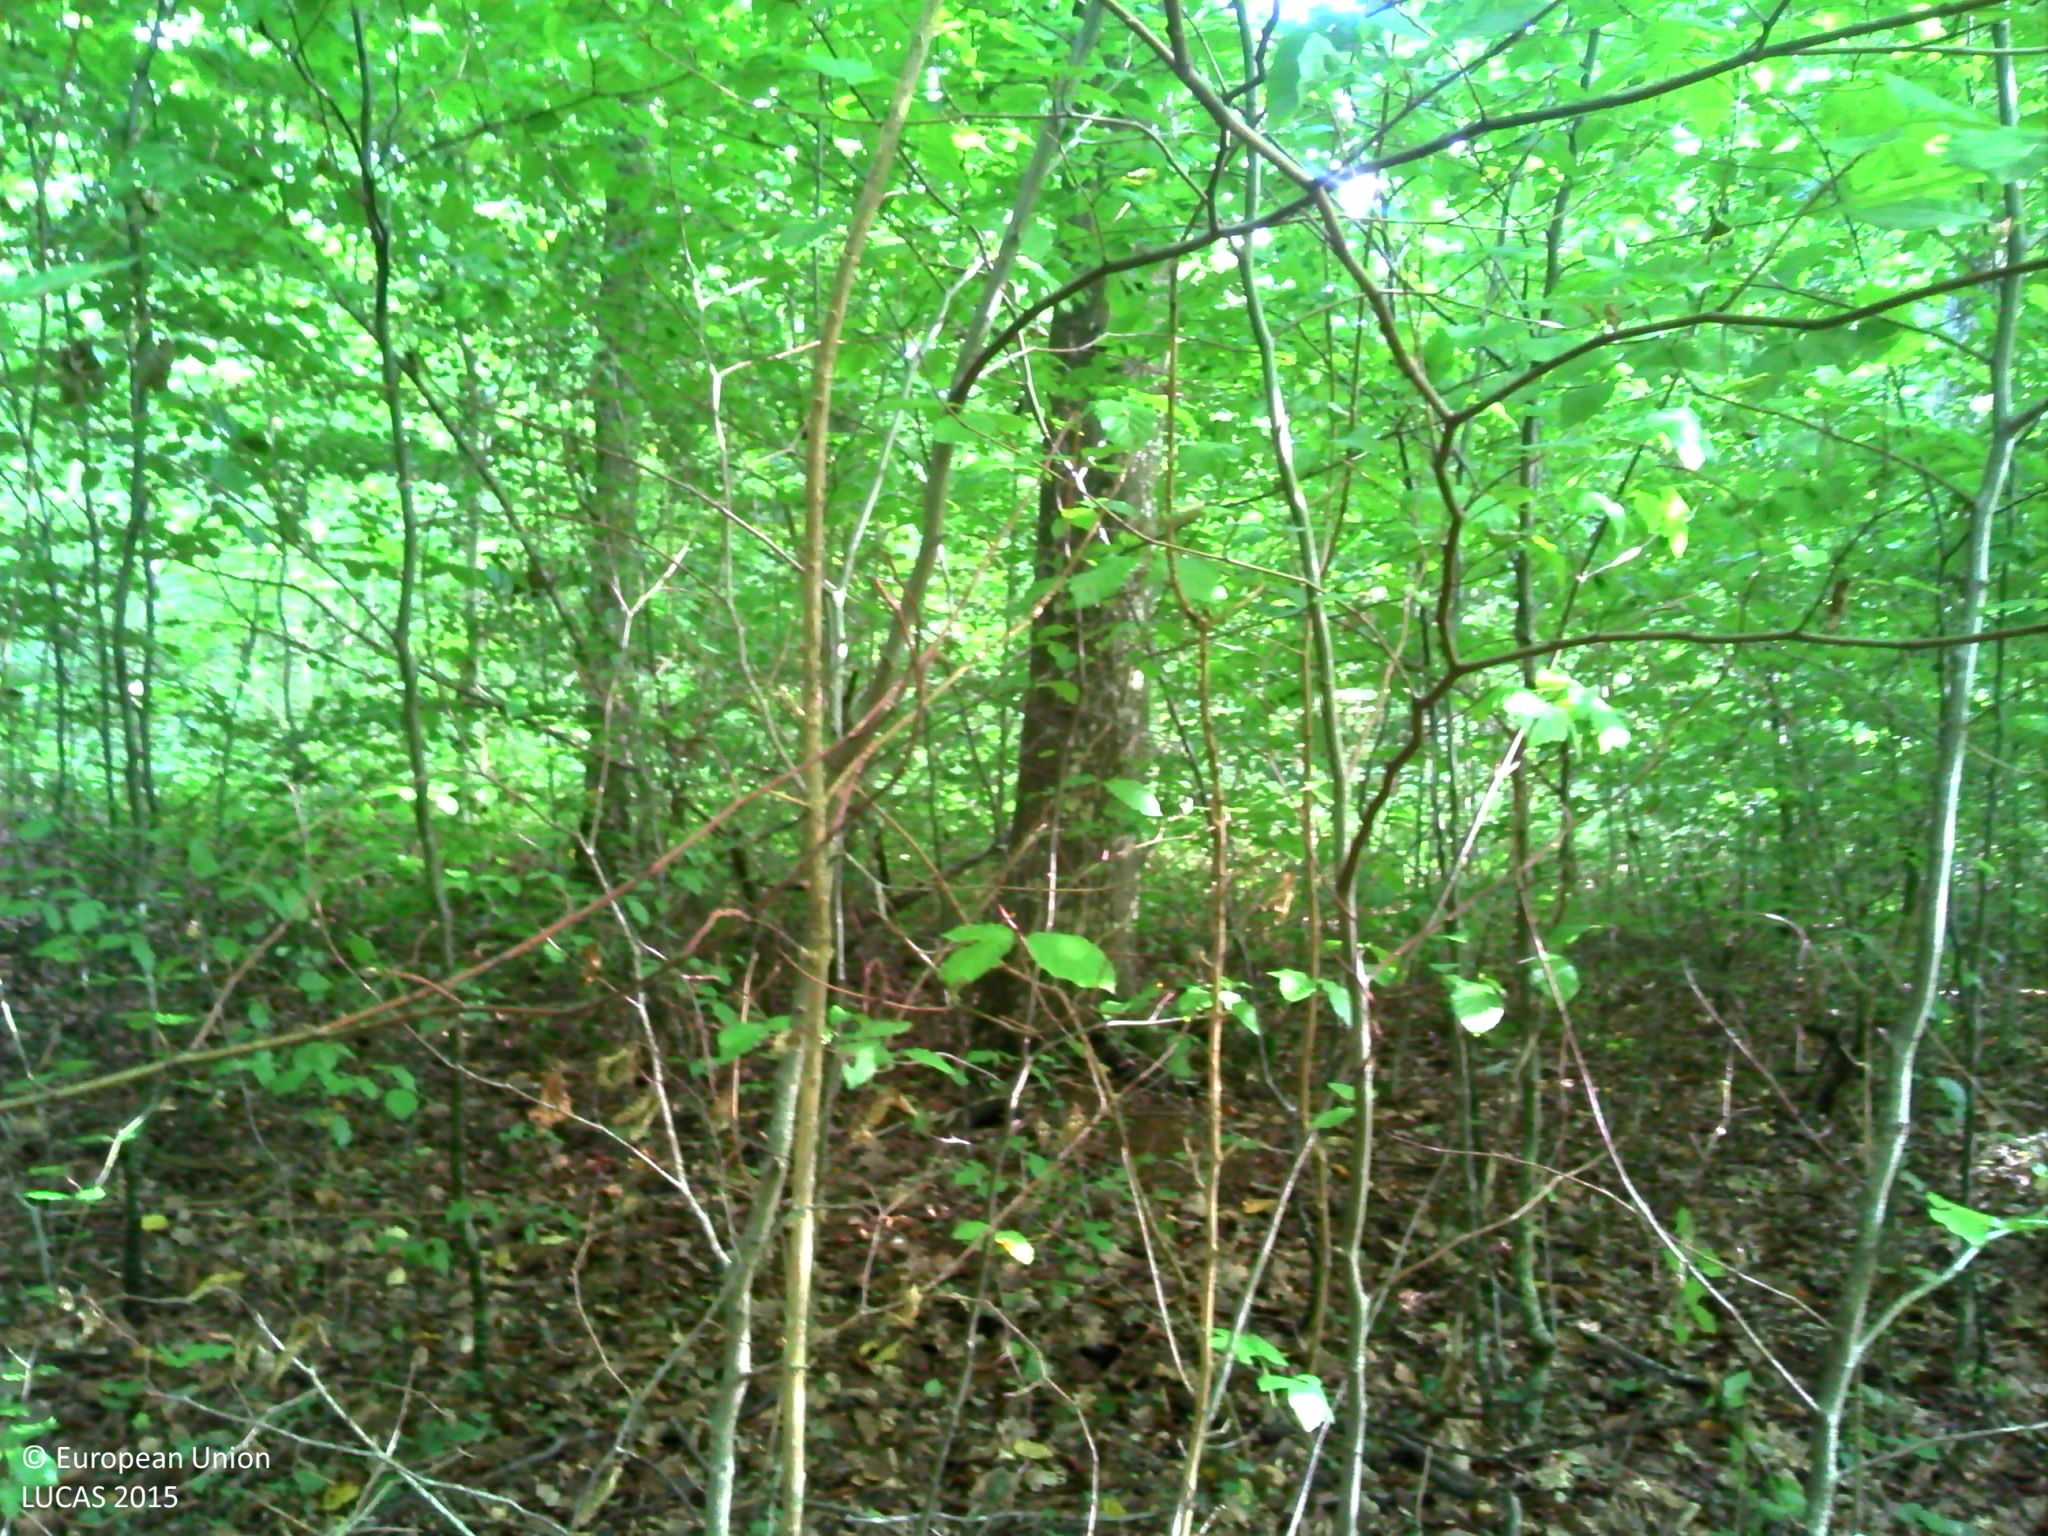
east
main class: Woodland
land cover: Broadleaved woodland
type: mesophytic deciduous forest
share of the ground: > 75 %
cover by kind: broadleaved forest trees 90 %, herbaceous plants 5 %, consolidated bare surface 5 %
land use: Forestry
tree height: > 5 m
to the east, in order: Broadleaved woodland; Grass margins; Broadleaved woodland; Tracks; Broadleaved woodland; Tracks; Broadleaved woodland; Other bare soil; Broadleaved woodland; Tracks; Broadleaved woodland; Tracks; Broadleaved woodland
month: September
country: FR
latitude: 48.8538
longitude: 6.0064
